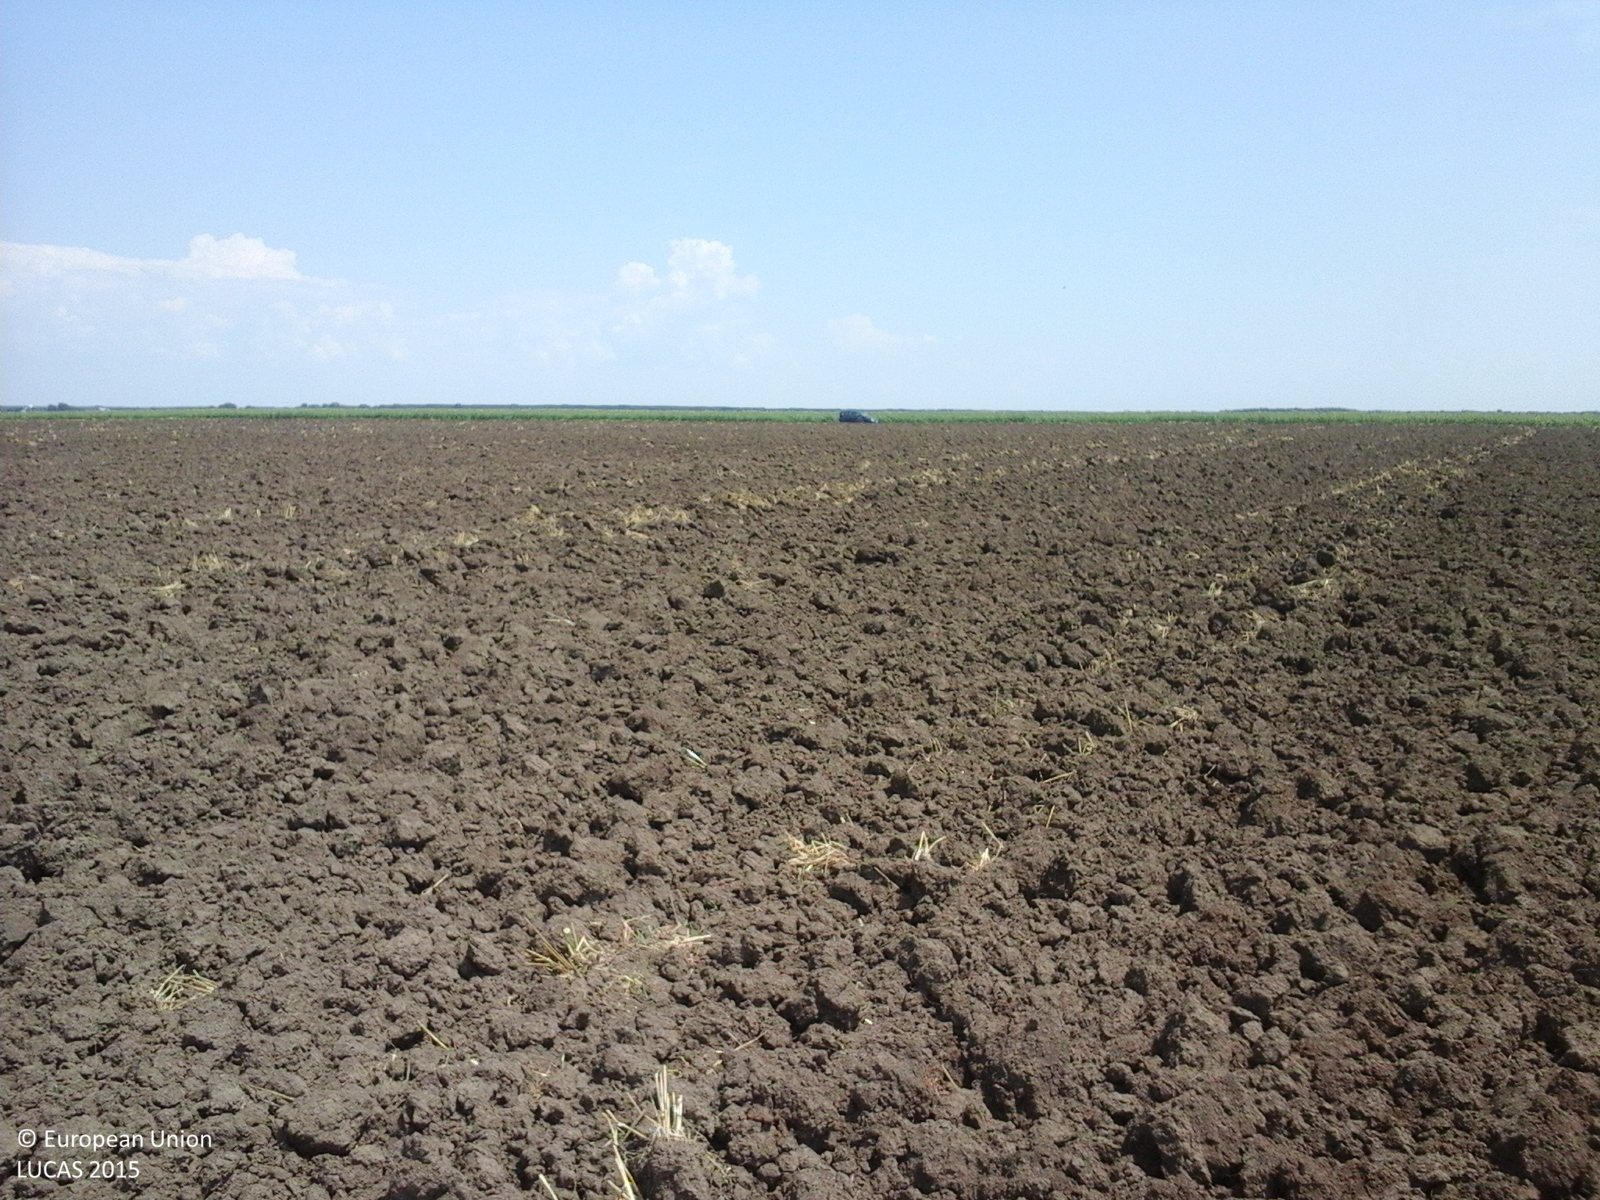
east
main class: Cropland
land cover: Common wheat
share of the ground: < 10 %
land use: Agriculture (excluding fallow land and kitchen gardens)
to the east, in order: Common wheat; Tracks; Sunflower
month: July
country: RO
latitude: 44.0900
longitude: 25.7684
